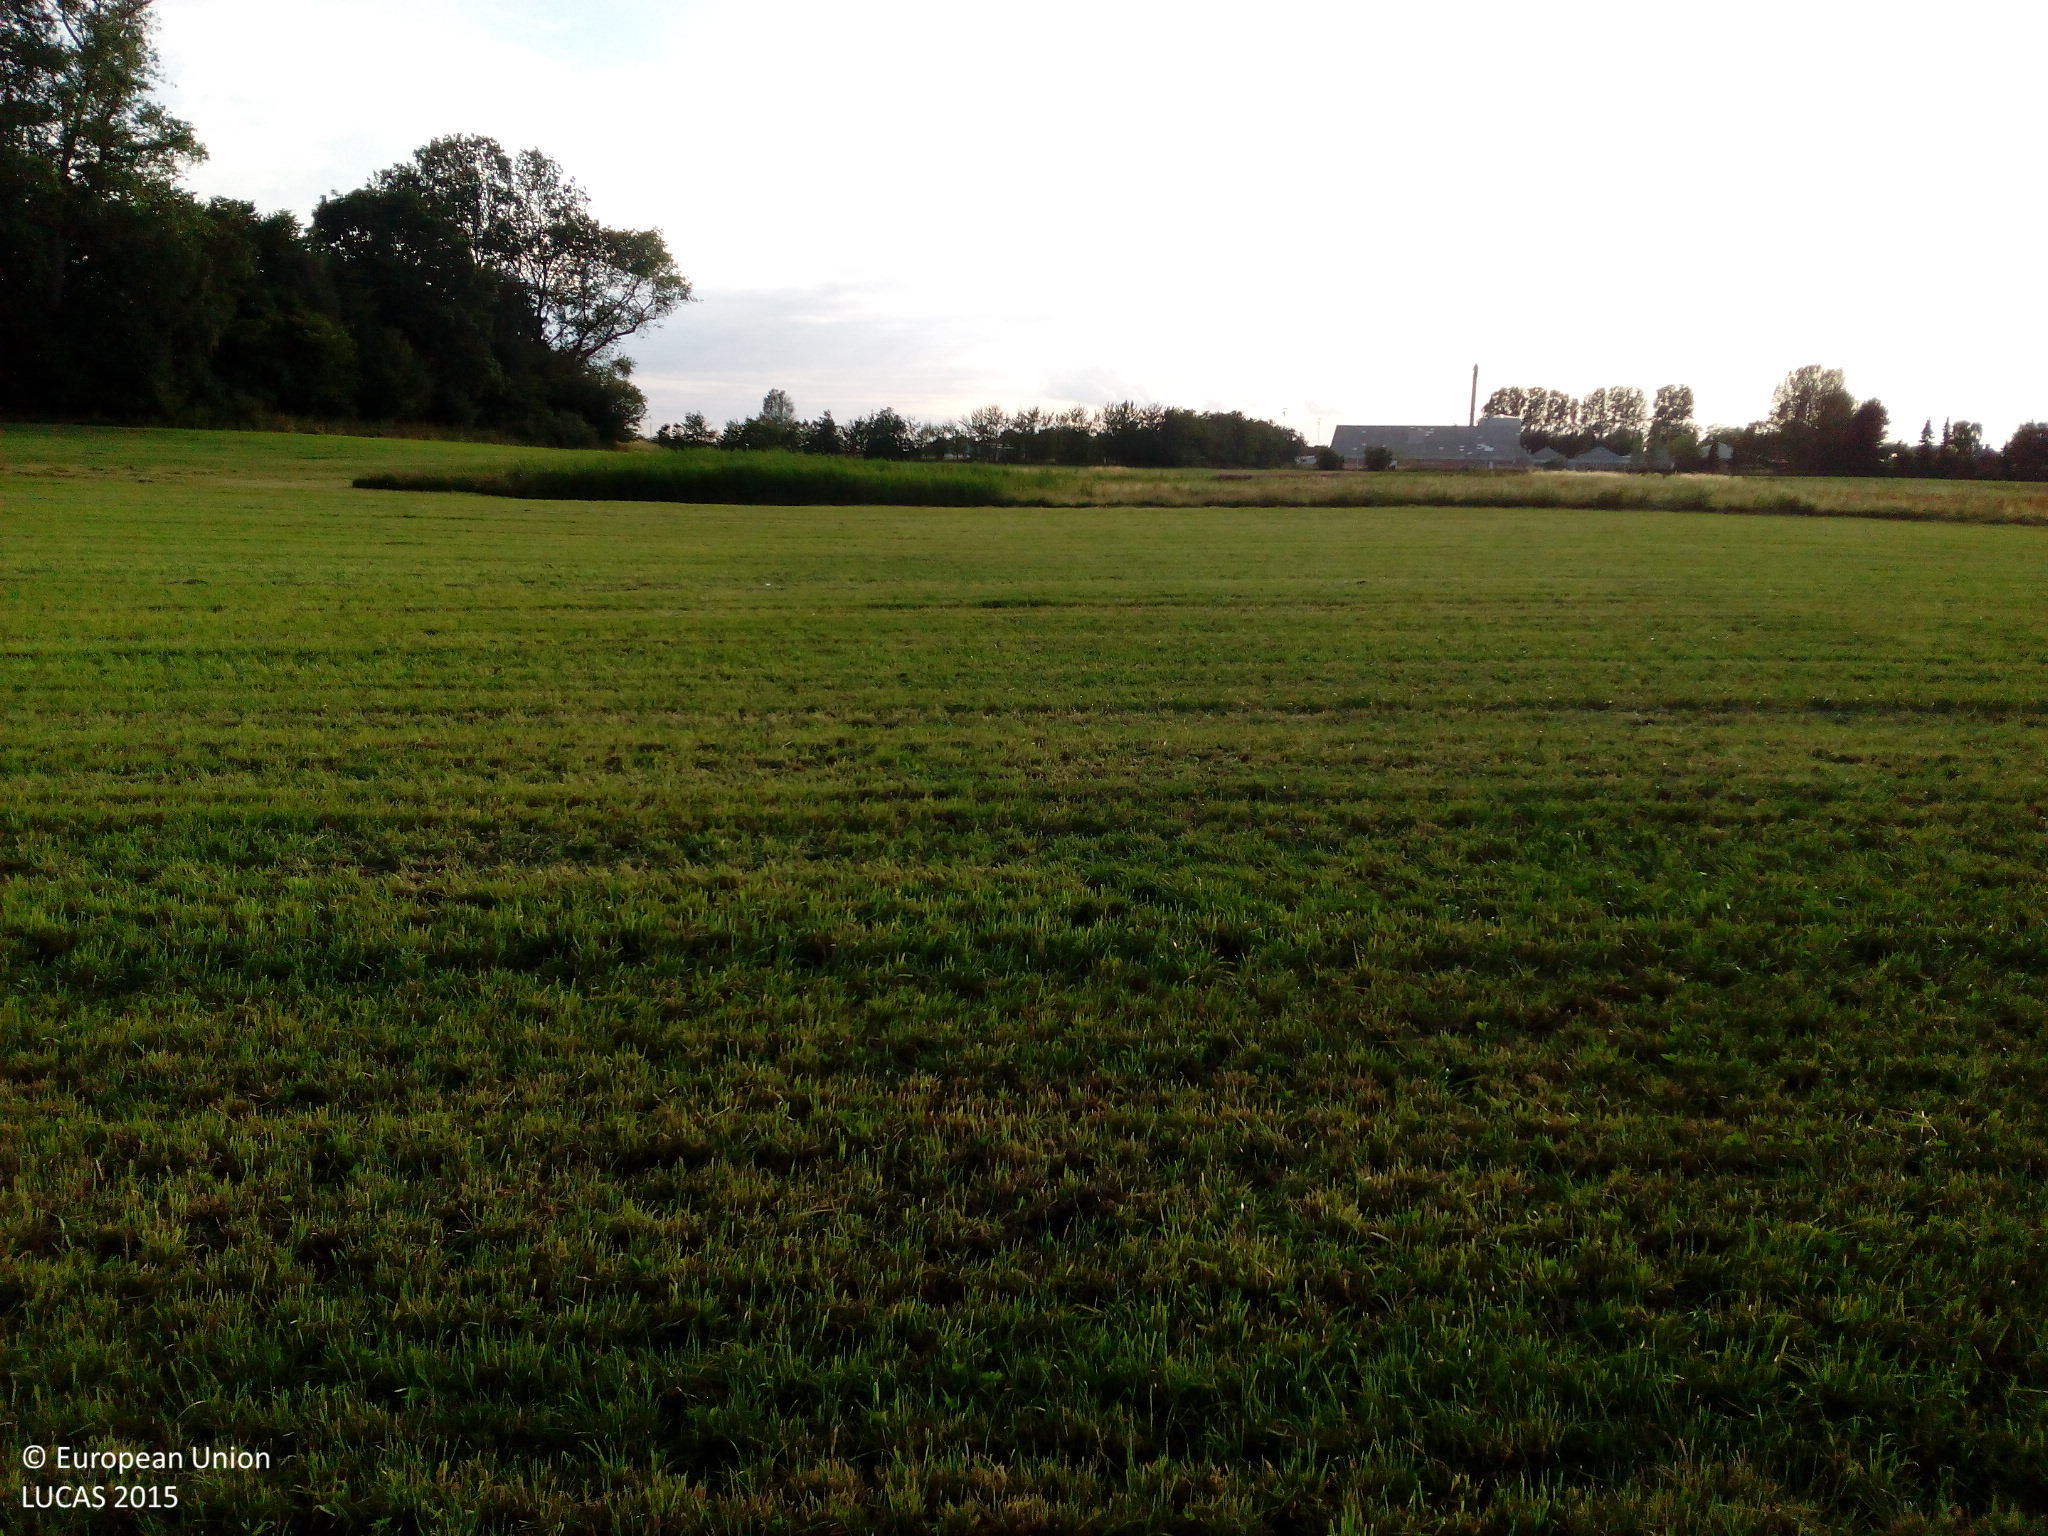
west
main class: Grassland
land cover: Grassland without tree/shrub cover
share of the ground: > 75 %
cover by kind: herbaceous plants 100 %
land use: Agriculture (excluding fallow land and kitchen gardens)
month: July
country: DK
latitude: 55.9358
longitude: 12.1591
